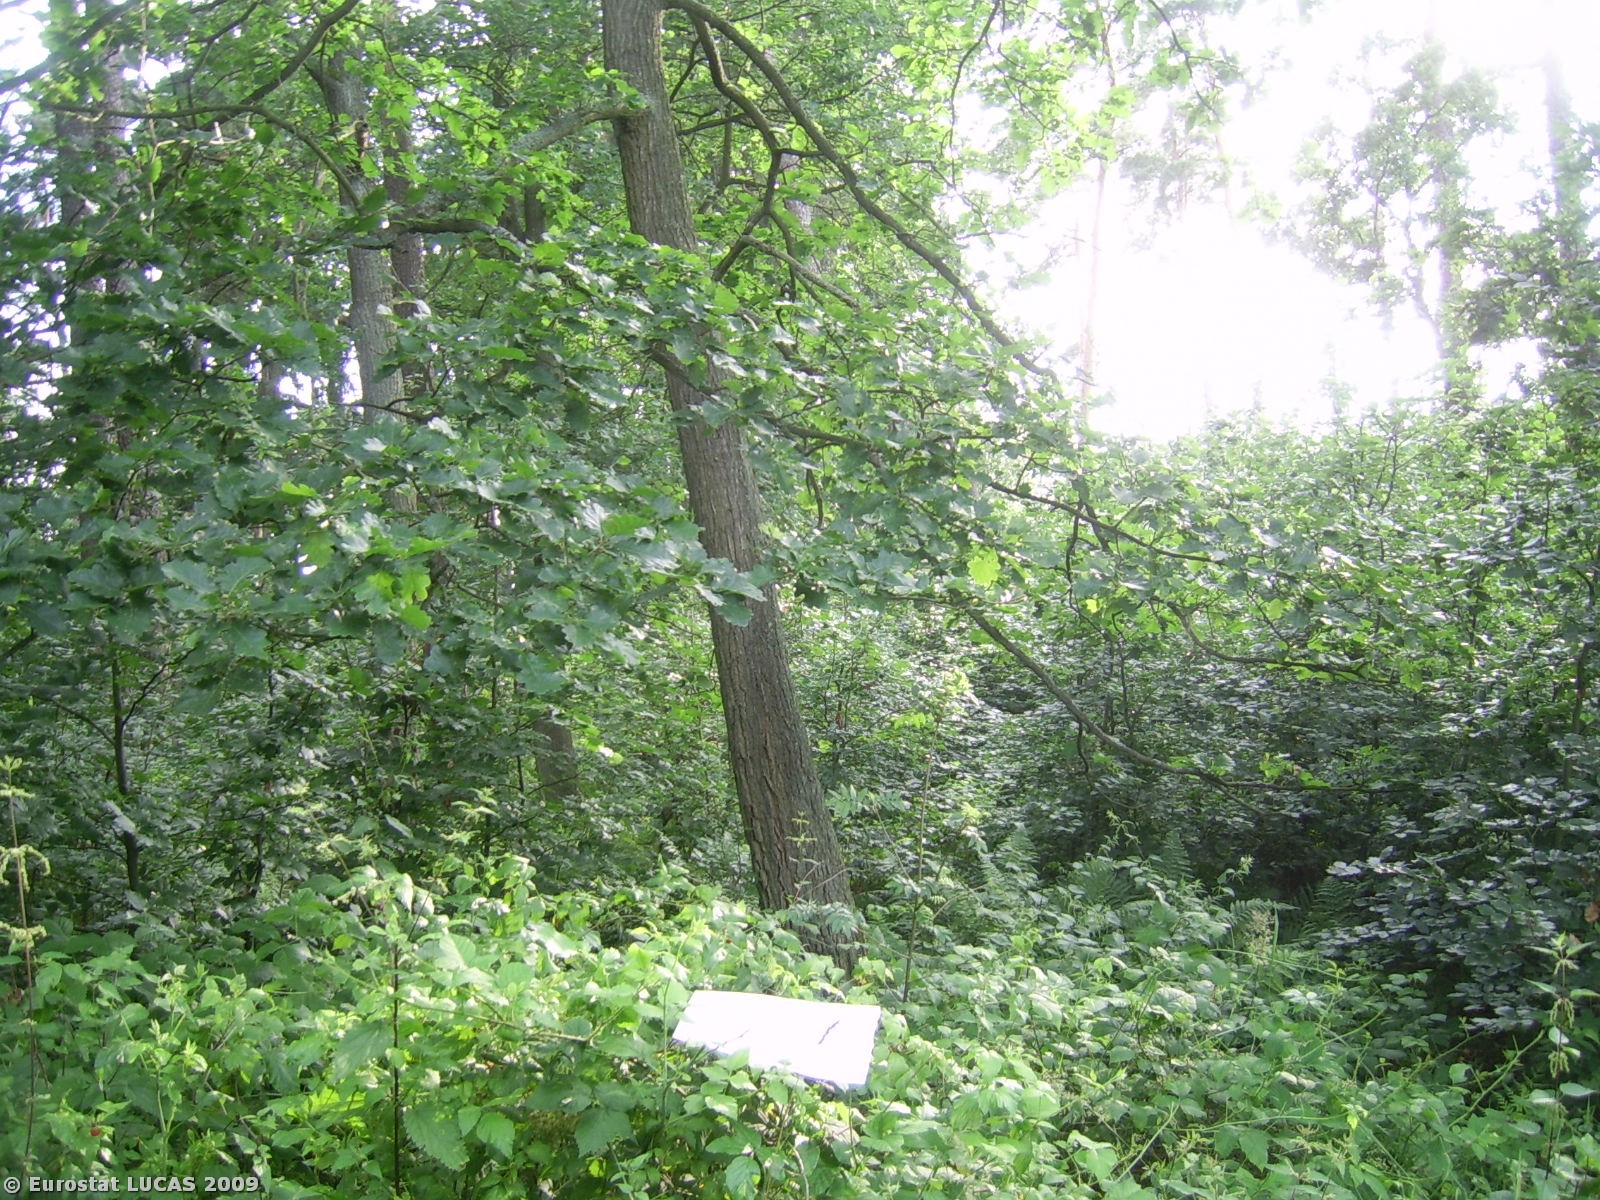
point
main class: Woodland
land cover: Mixed woodland
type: hemiboreal forest and nemoral coniferous forest and mixed broadleaved-coniferous forest
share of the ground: 50 - 75 %
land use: Nature reserves
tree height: > 5 m
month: July
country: PL
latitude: 52.5334
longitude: 18.1096
